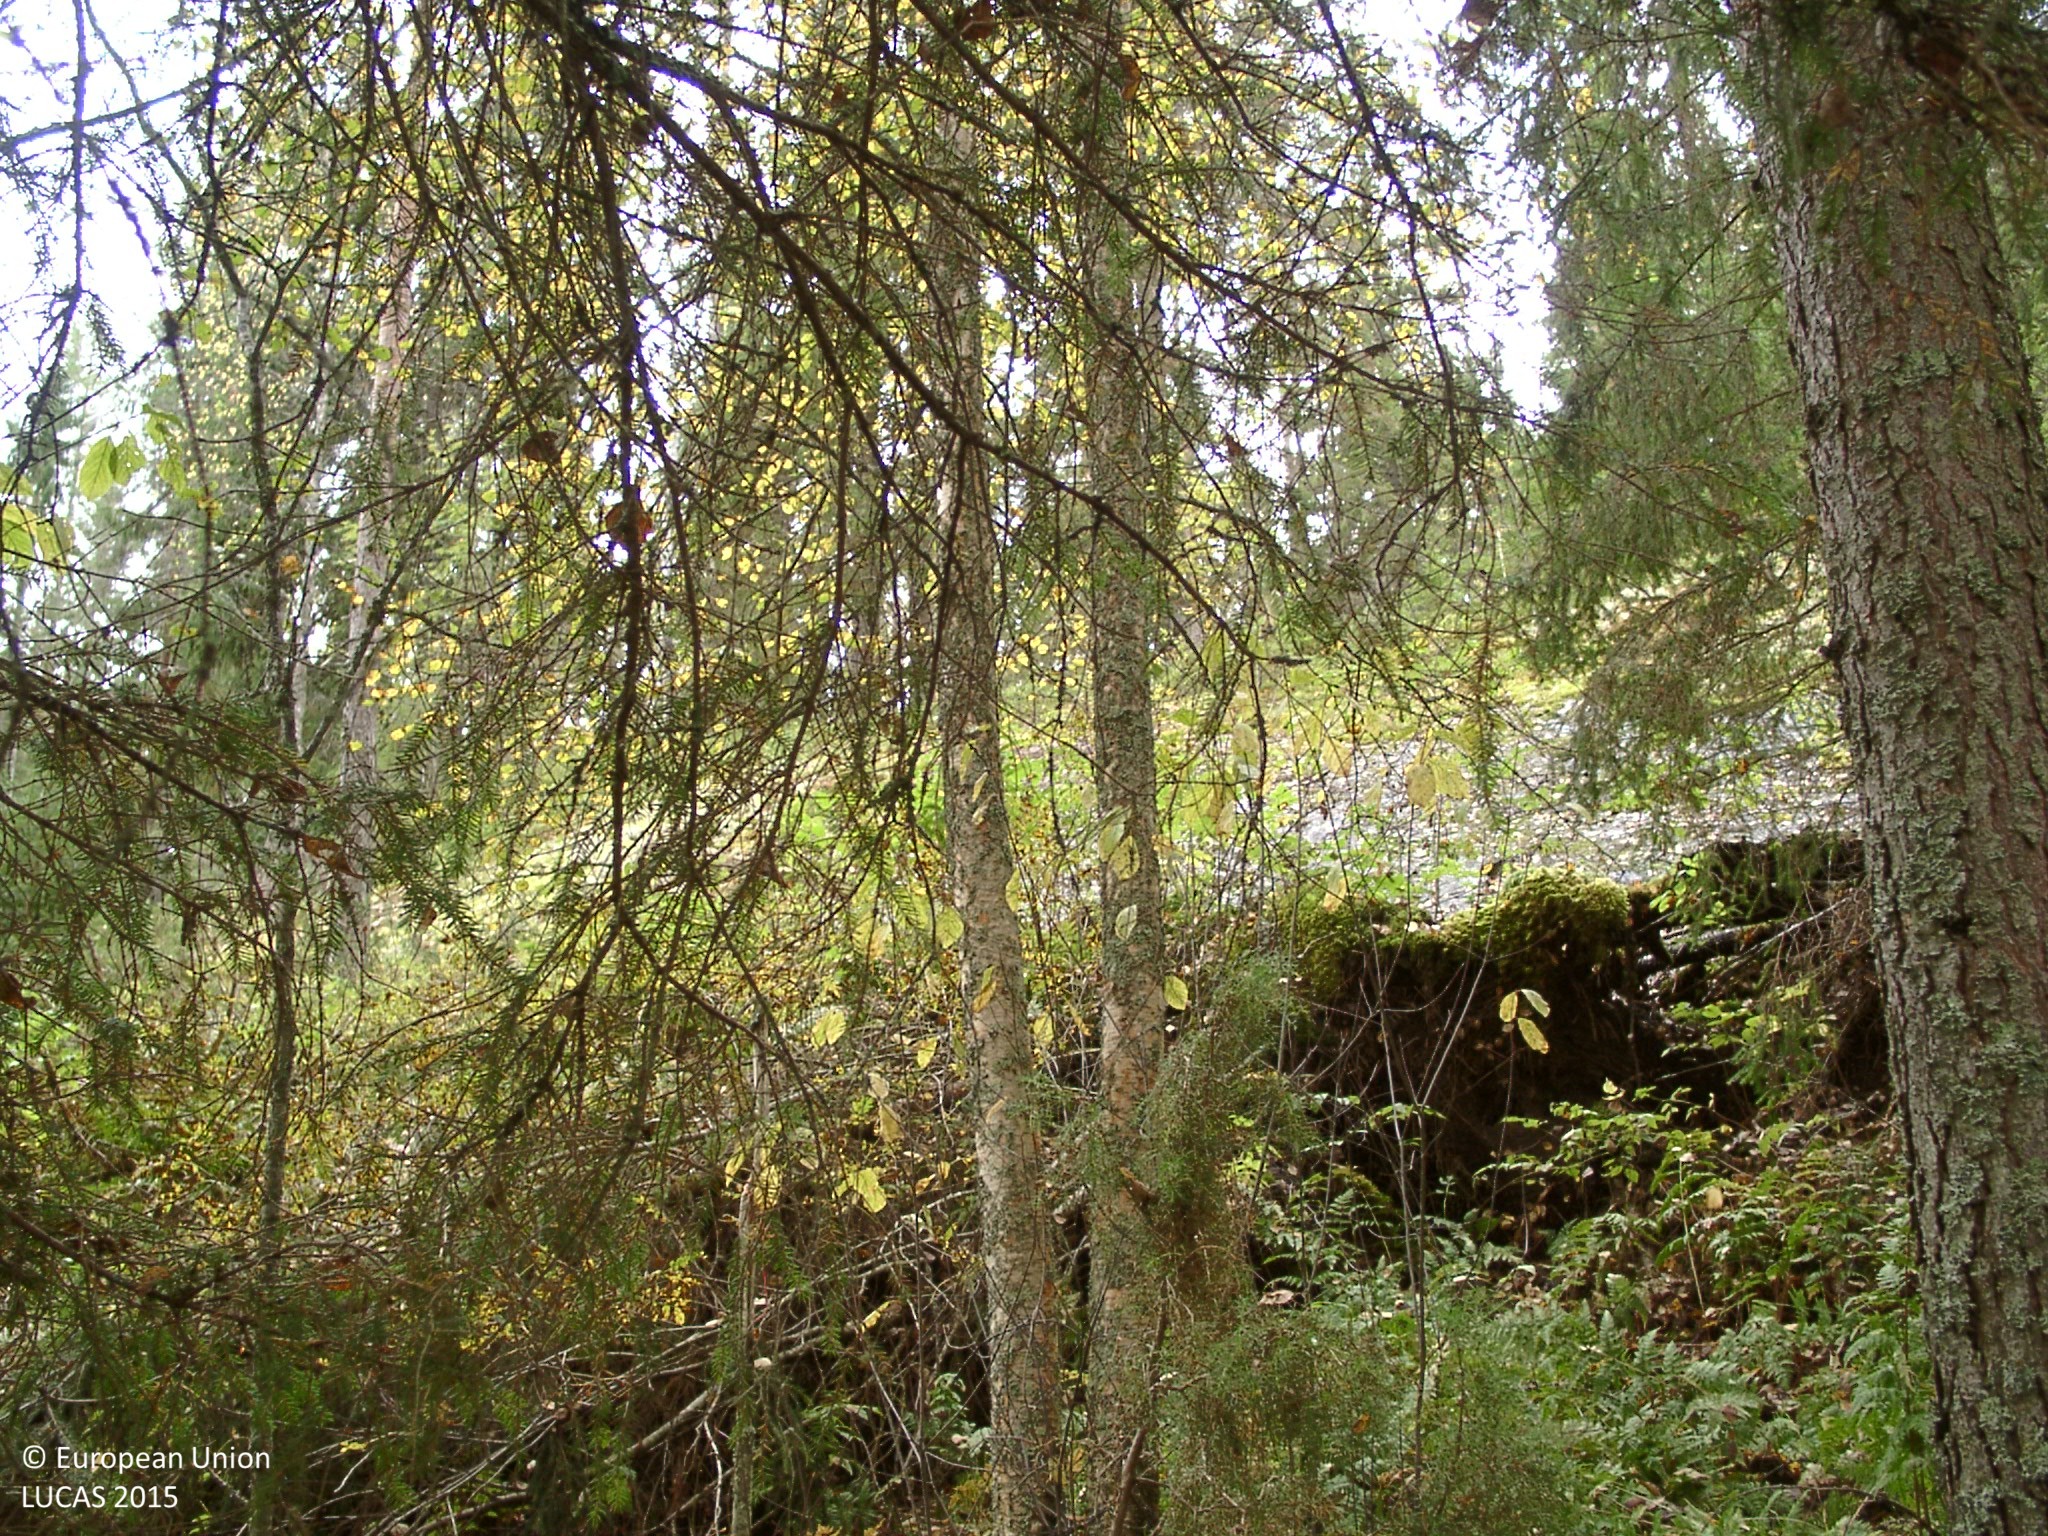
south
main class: Woodland
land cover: Spruce dominated mixed woodland
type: boreal forest
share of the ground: 50 - 75 %
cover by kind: broadleaved forest trees 35 %, coniferous forest trees 30 %, herbaceous plants 20 %, shrubs 10 %, unconsolidated bare surface 5 %
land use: Forestry
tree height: > 5 m
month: September
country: FI
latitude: 62.8715
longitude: 25.8624
